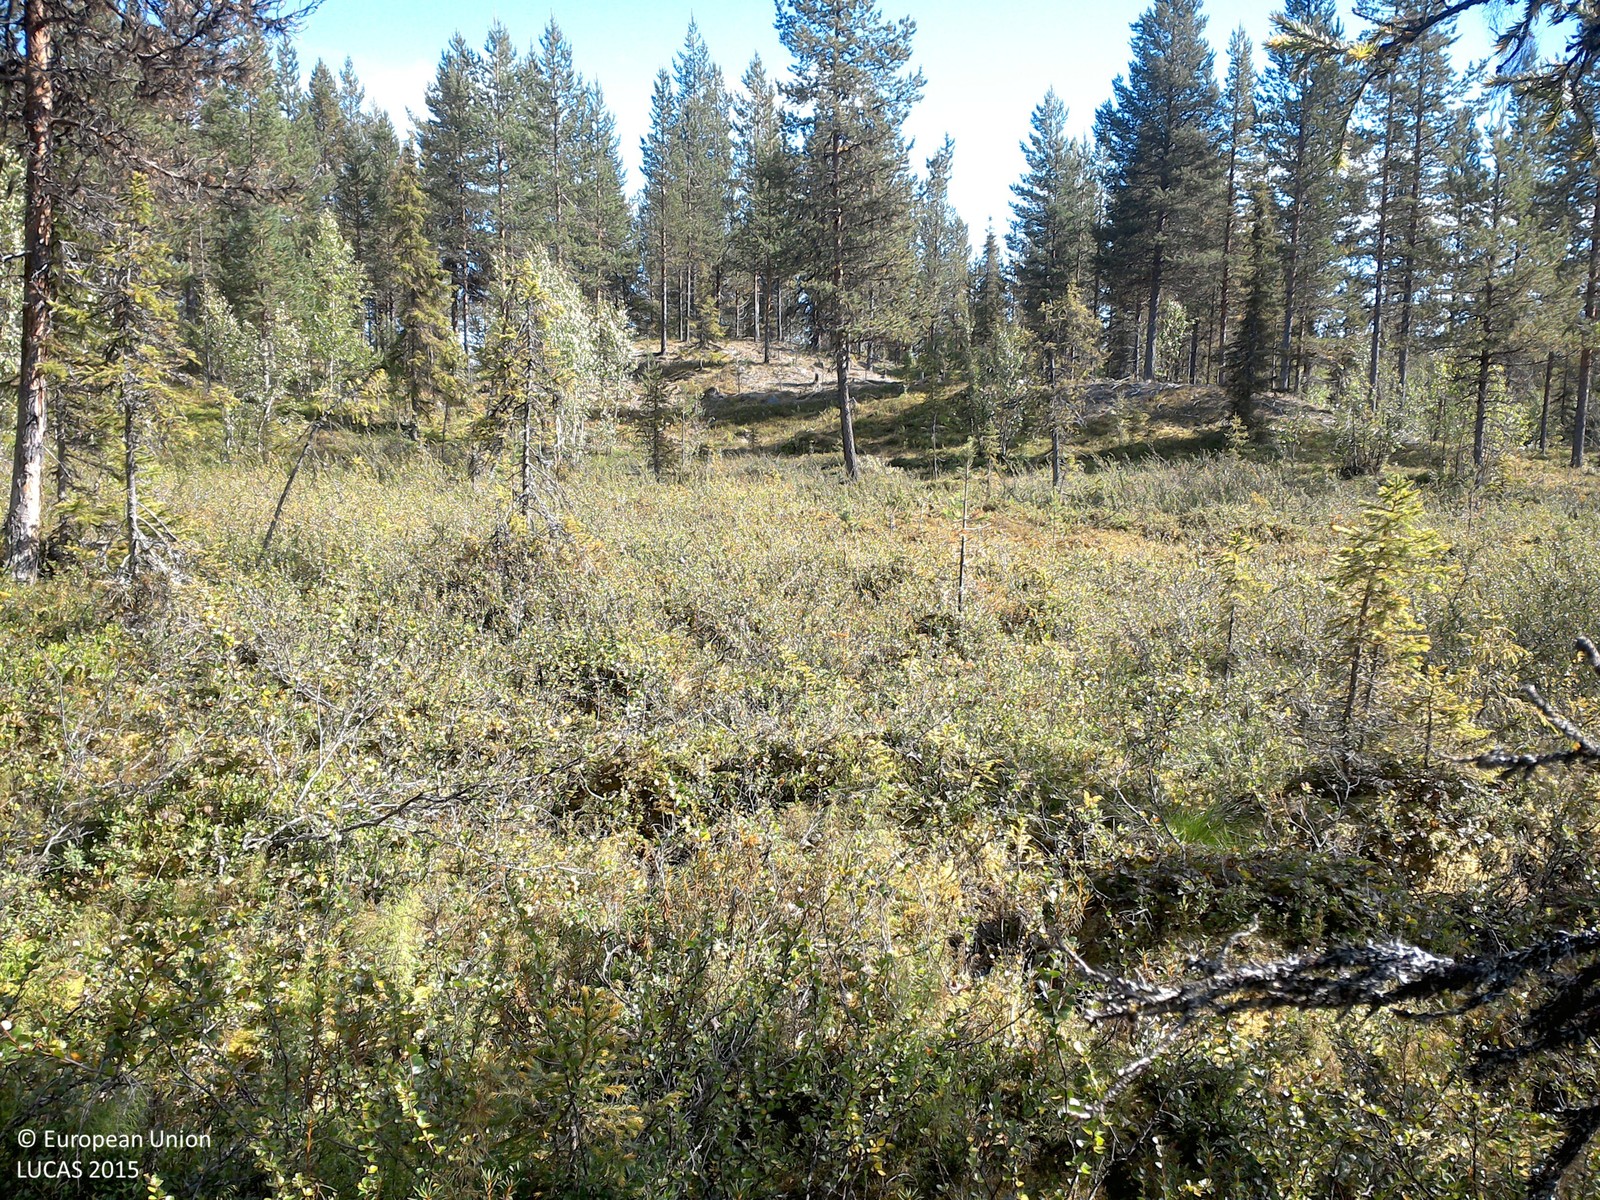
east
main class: Woodland
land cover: Pine dominated mixed woodland
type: boreal forest
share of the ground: 25 - 50 %
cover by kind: shrubs 70 %, coniferous forest trees 15 %, broadleaved forest trees 10 %, lichens and mosses 5 %
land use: Forestry
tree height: > 5 m
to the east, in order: Pine dominated mixed woodland; Shrubland with sparse tree cover; Pine dominated mixed woodland; Pine dominated coniferous woodland; Pine dominated mixed woodland; Spruce dominated mixed woodland; Pine dominated mixed woodland; Spruce dominated mixed woodland
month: August
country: SE
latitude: 67.4227
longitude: 21.2223
